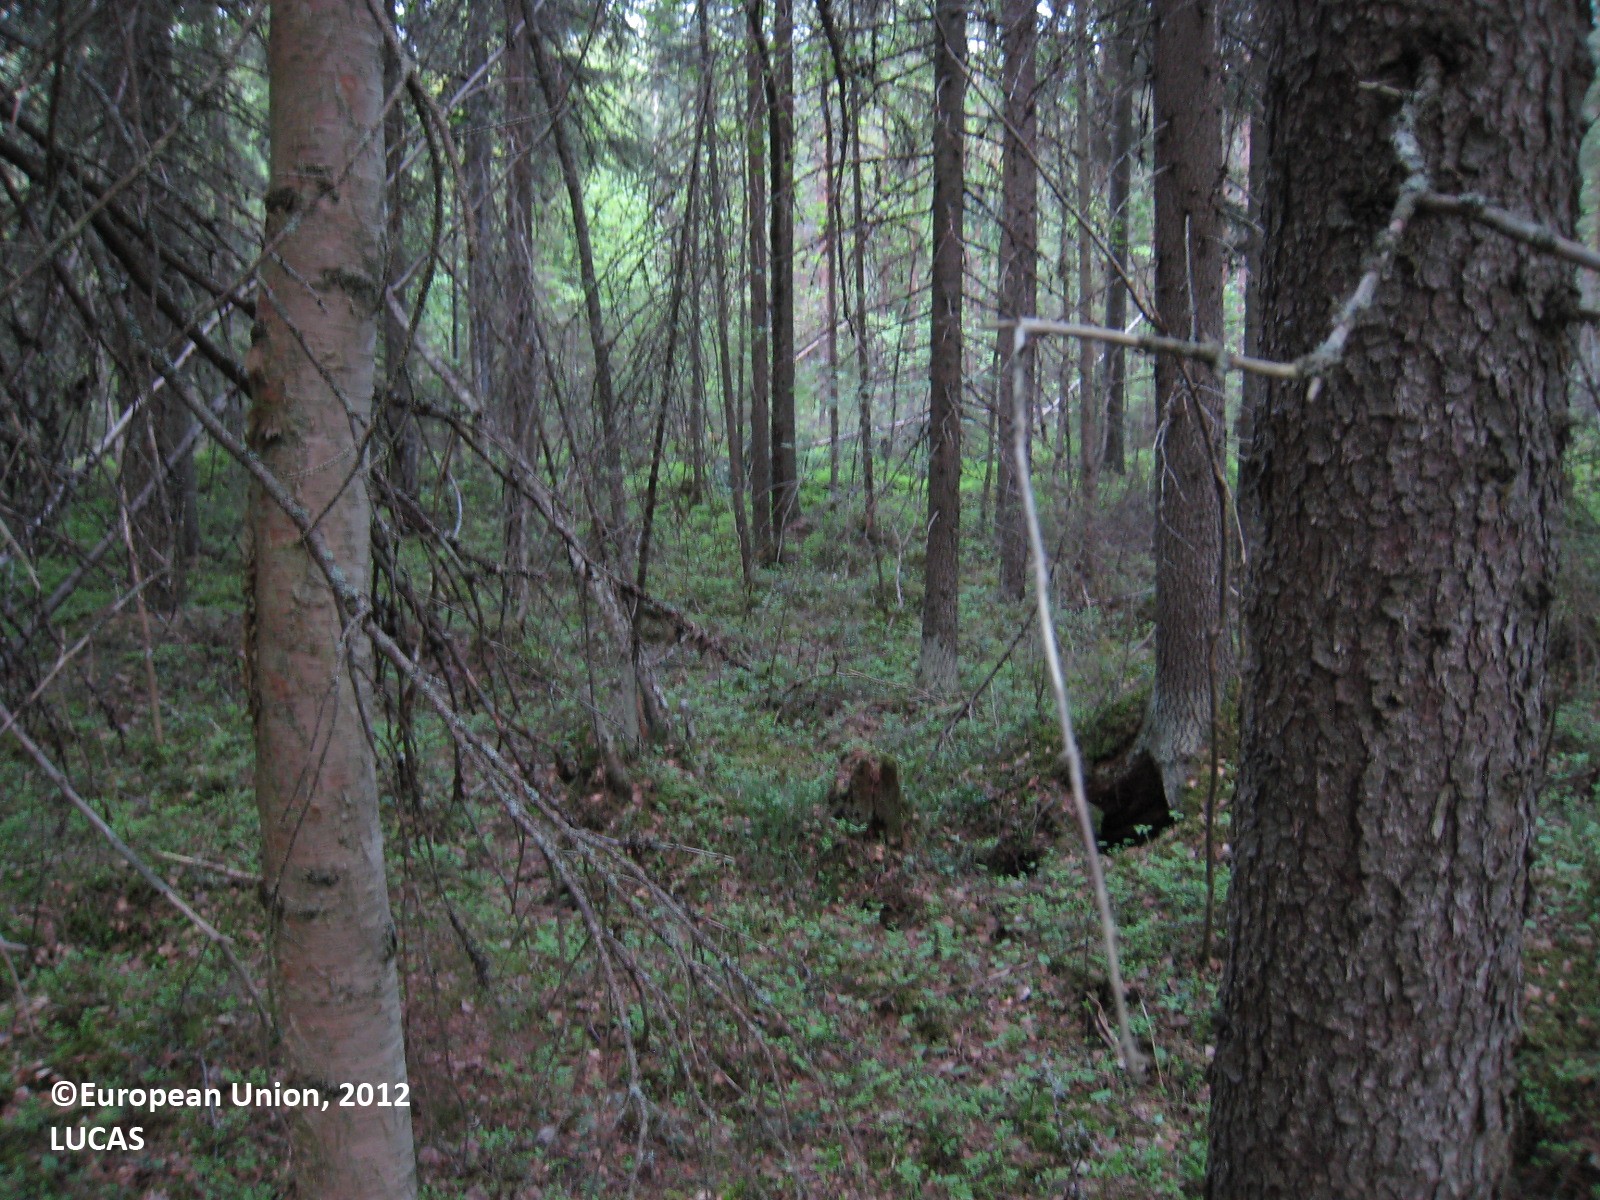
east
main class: Woodland
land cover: Spruce dominated mixed woodland
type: boreal forest
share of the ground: > 75 %
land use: Forestry
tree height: > 5 m
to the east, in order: Spruce dominated mixed woodland; Pine dominated mixed woodland; Spruce dominated coniferous woodland; Other mixed woodland
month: June
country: FI
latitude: 62.5686
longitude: 26.1005
